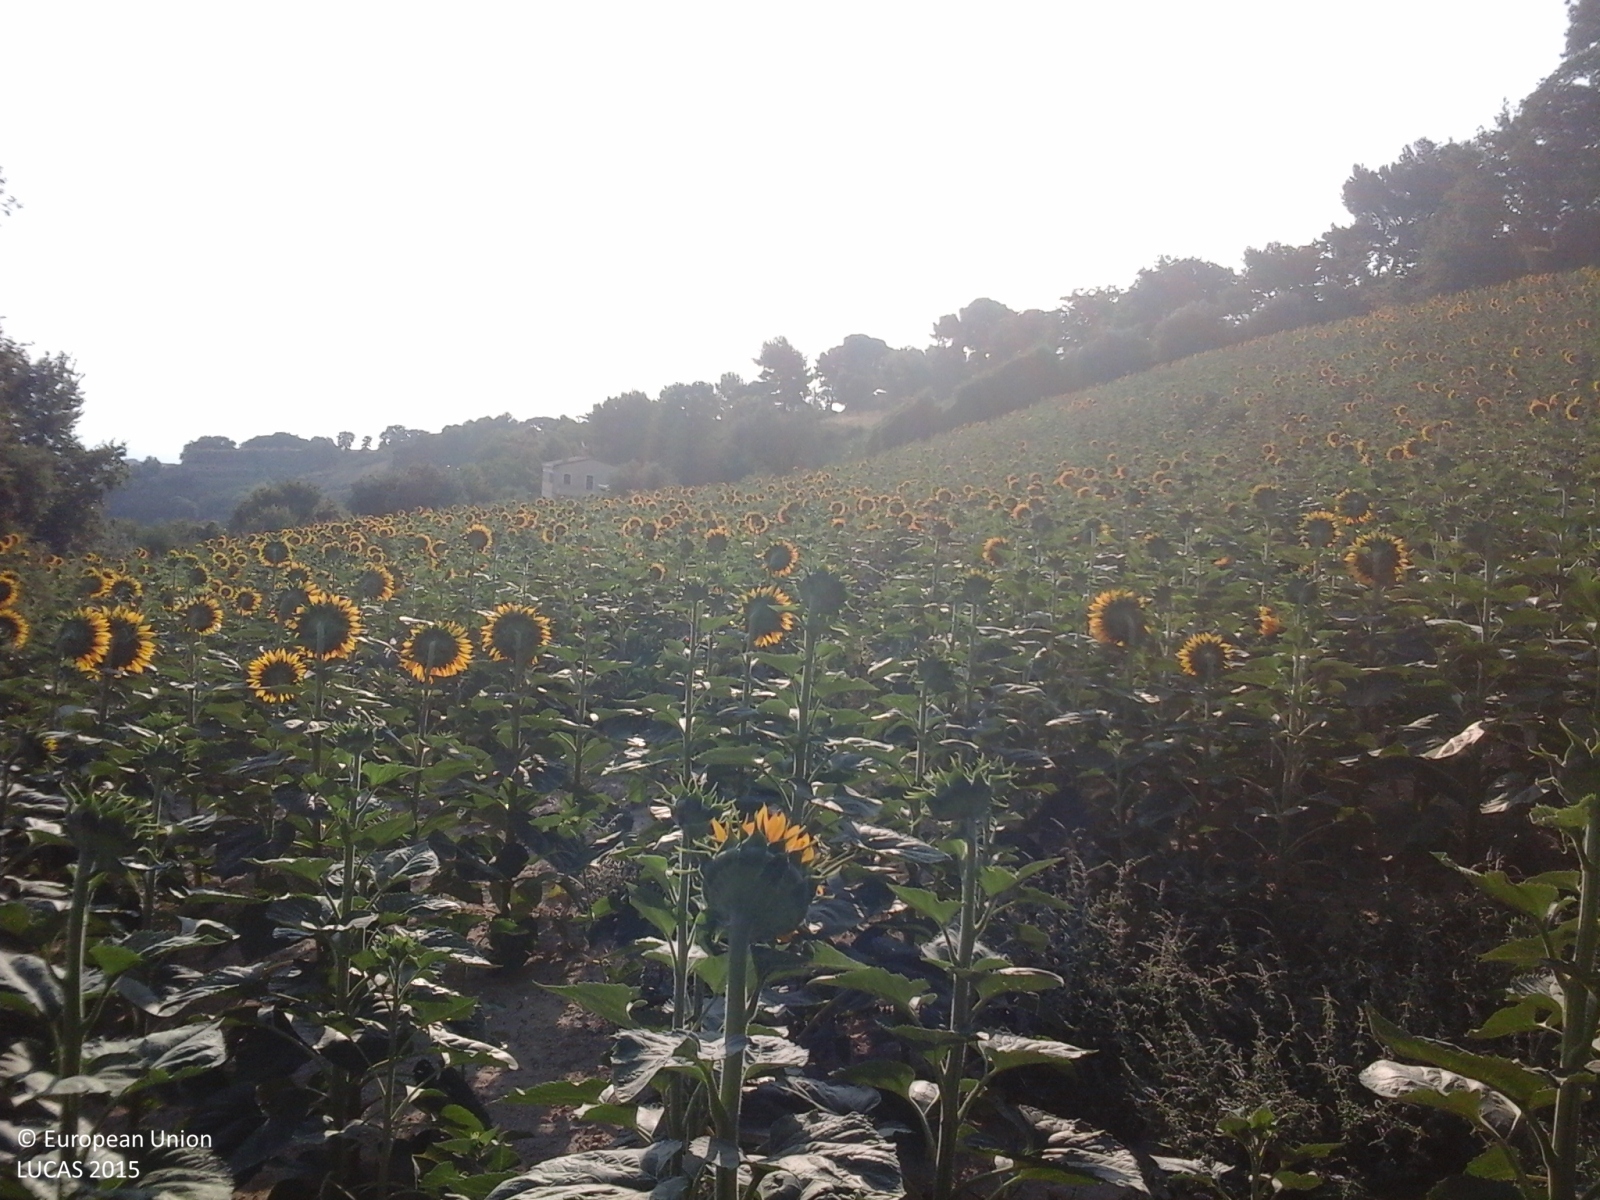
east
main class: Cropland
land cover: Sunflower
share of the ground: > 75 %
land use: Agriculture (excluding fallow land and kitchen gardens)
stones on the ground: < 10 %
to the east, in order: Sunflower; Managed hedges; Olive groves; Lines of trees; Paved roads, cycling and walking lanes; Spontaneously vegetated surfaces; Electric lines; Spontaneously vegetated surfaces
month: July
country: IT
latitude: 43.0704
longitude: 13.8093
